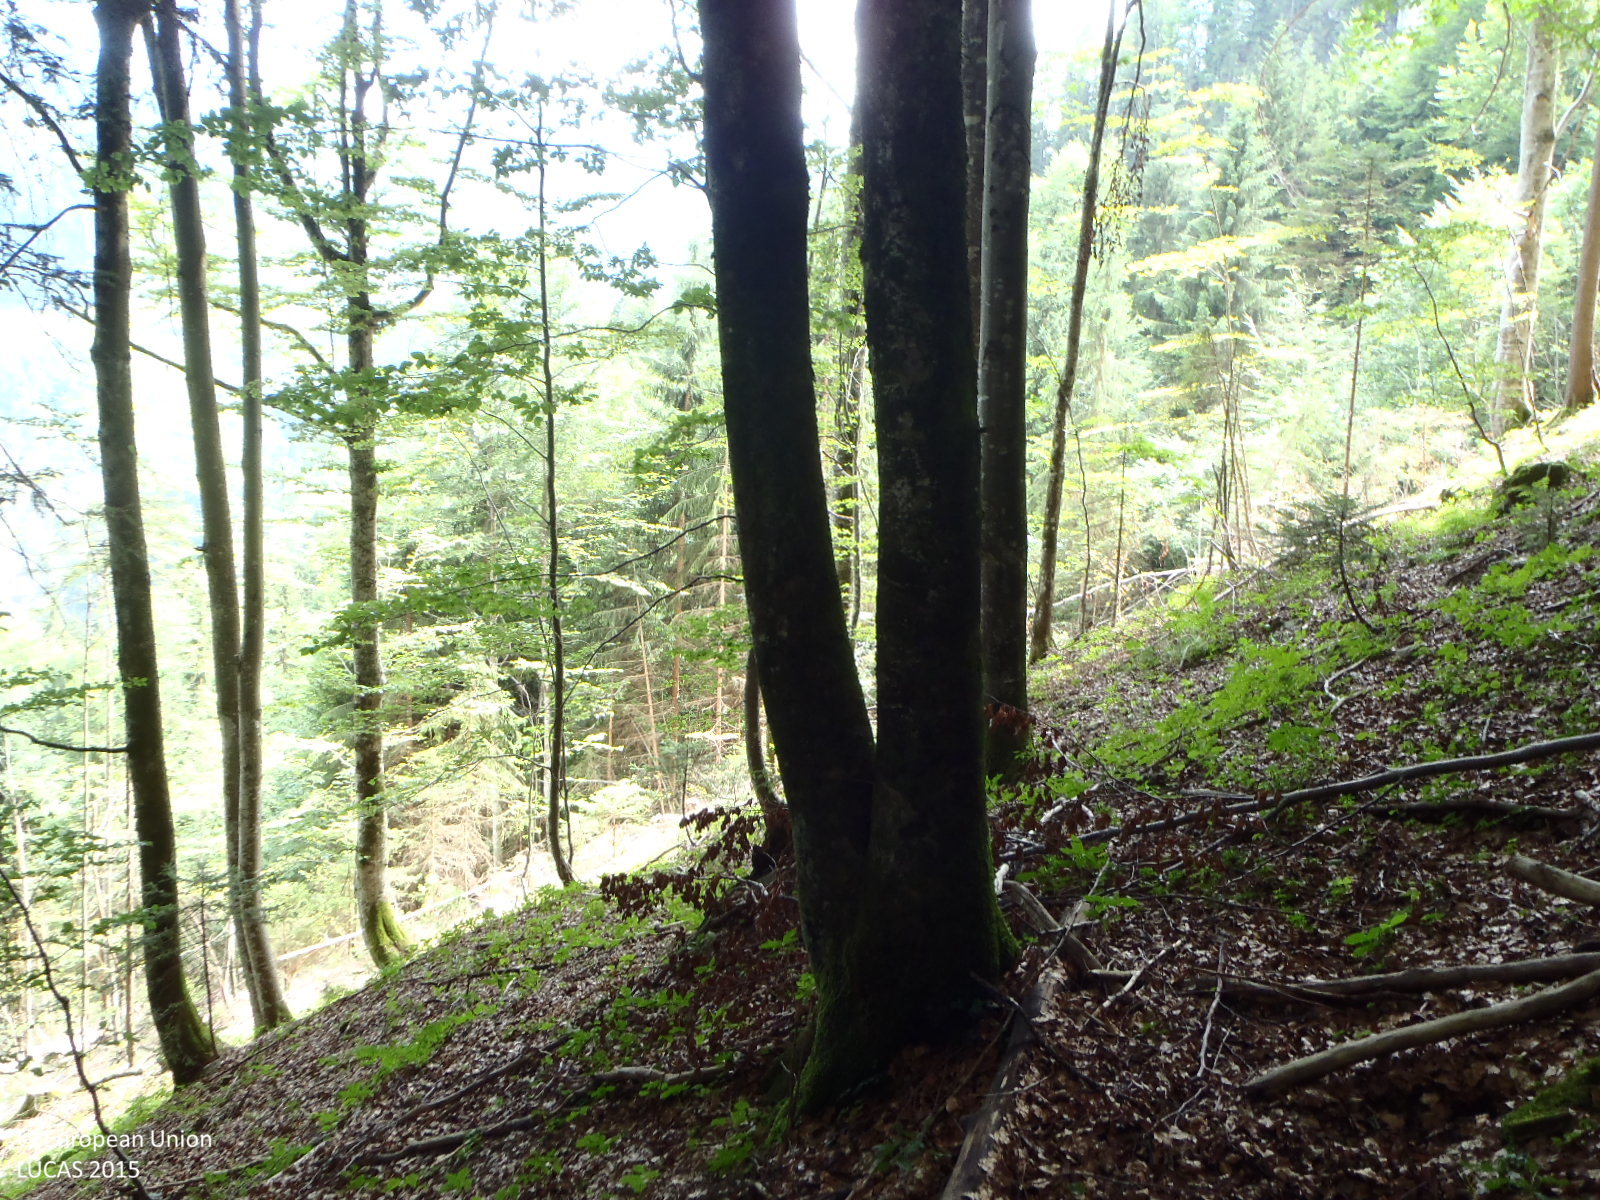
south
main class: Woodland
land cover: Broadleaved woodland
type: mountainous beech forest
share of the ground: > 75 %
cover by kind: broadleaved forest trees 85 %, coniferous forest trees 5 %, herbaceous plants 5 %, unconsolidated bare surface 5 %
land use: Forestry
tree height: > 5 m
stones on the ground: < 10 %
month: July
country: AT
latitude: 47.5747
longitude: 12.0325
